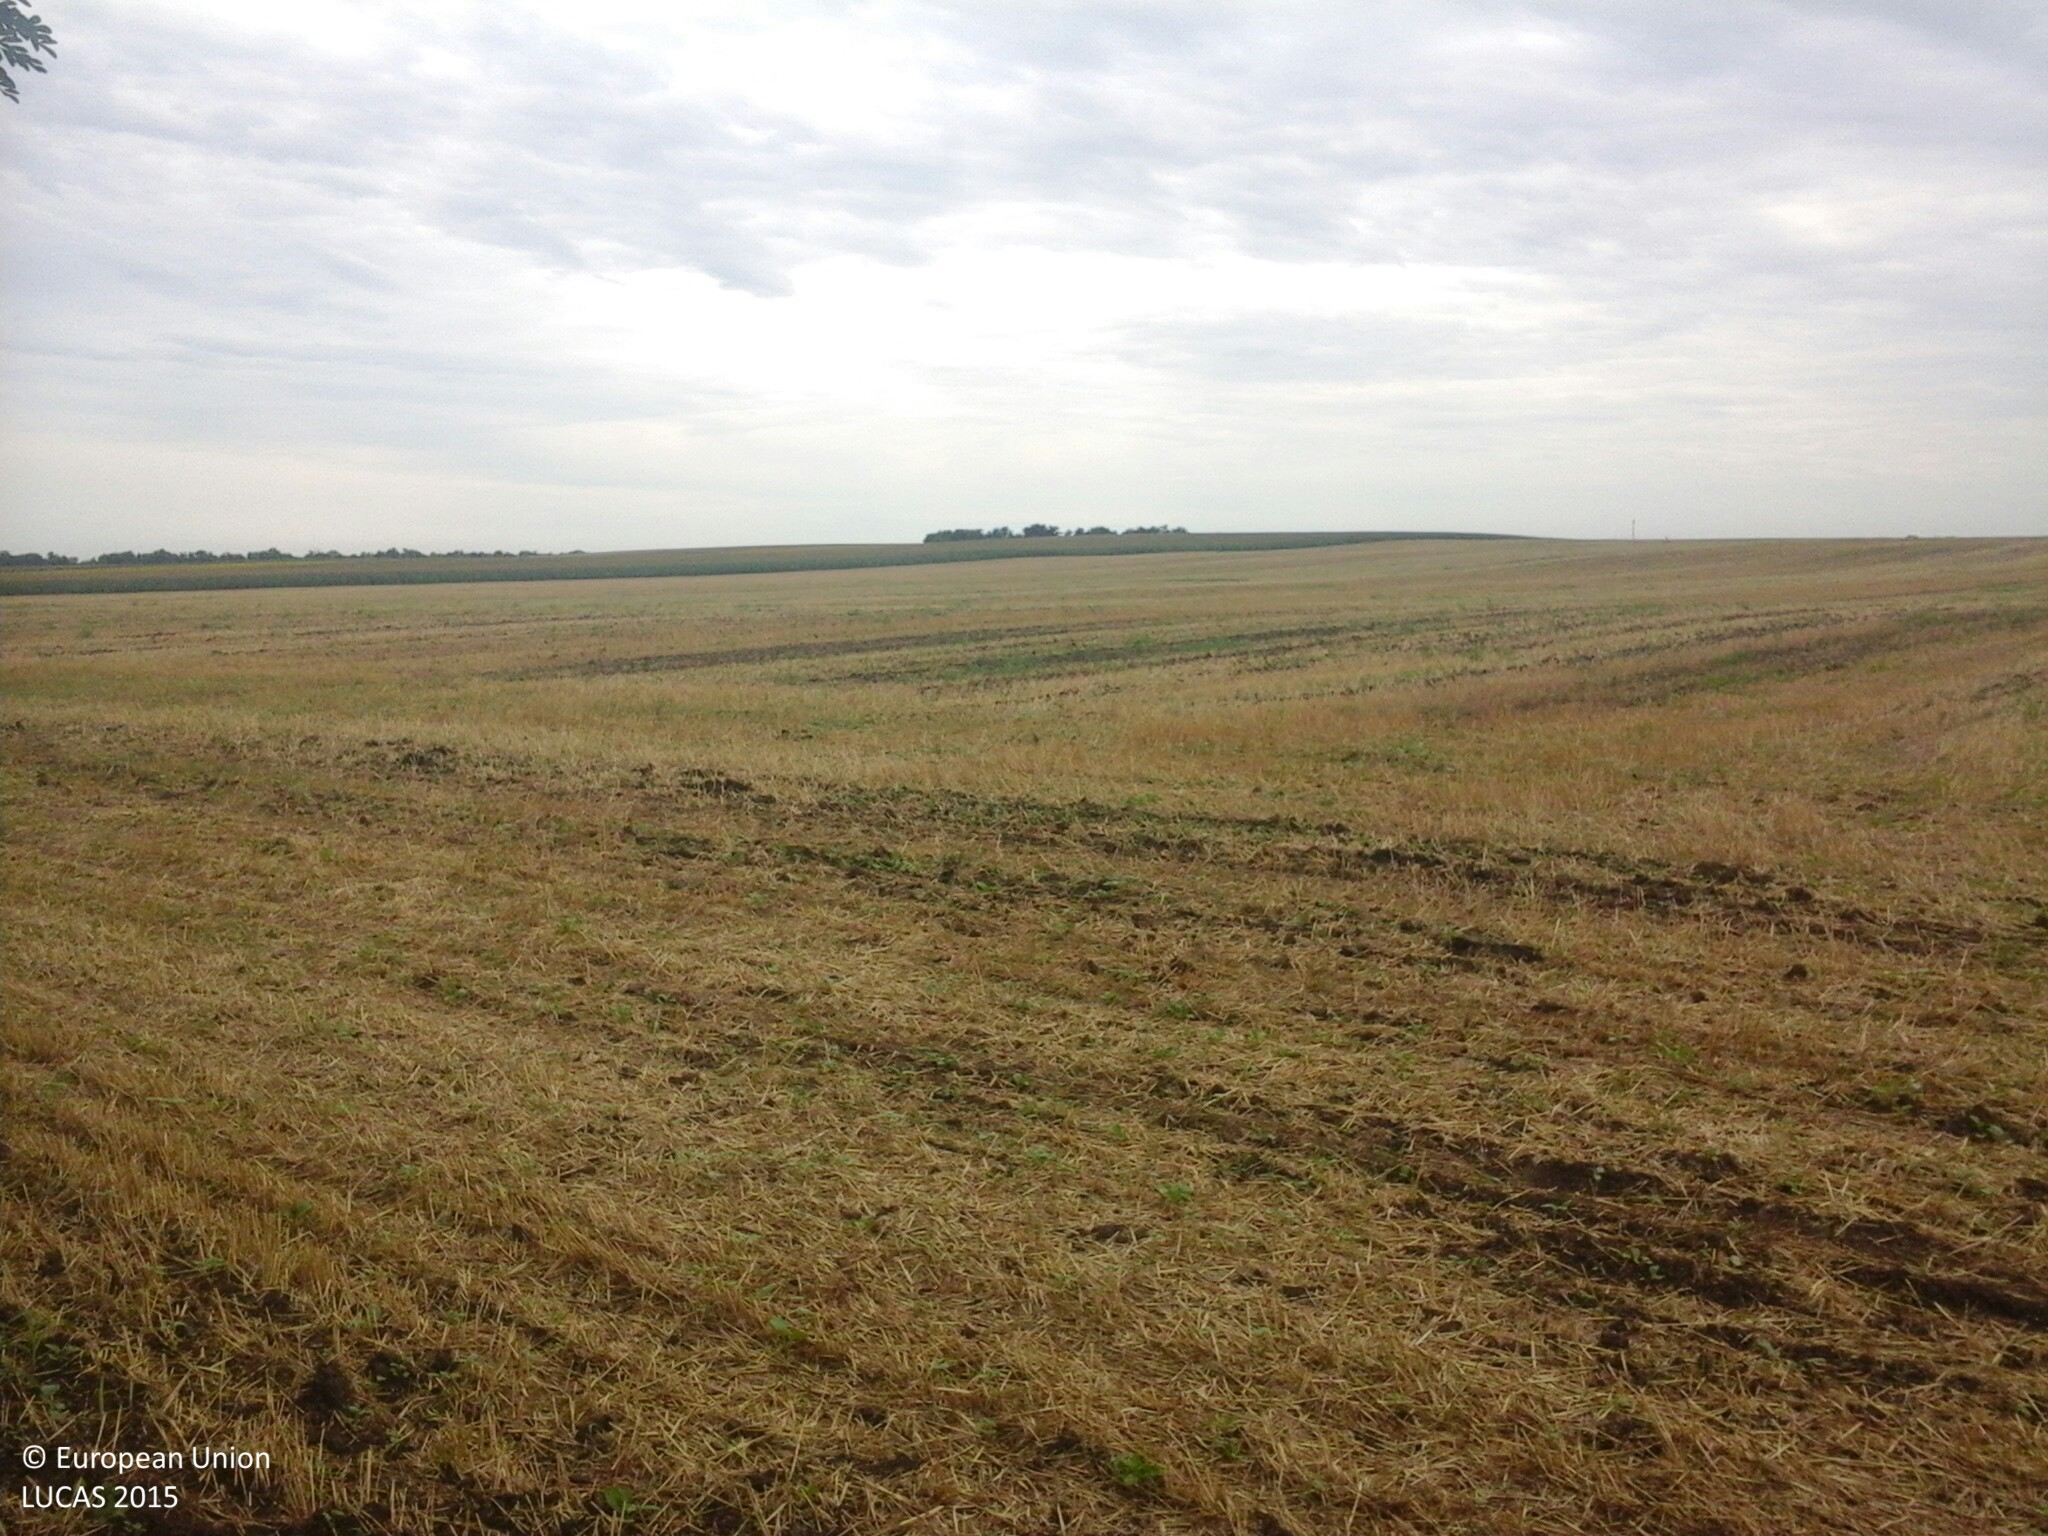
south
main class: Cropland
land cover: Maize
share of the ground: > 75 %
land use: Agriculture (excluding fallow land and kitchen gardens)
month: July
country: HU
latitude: 46.9589
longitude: 18.4350
